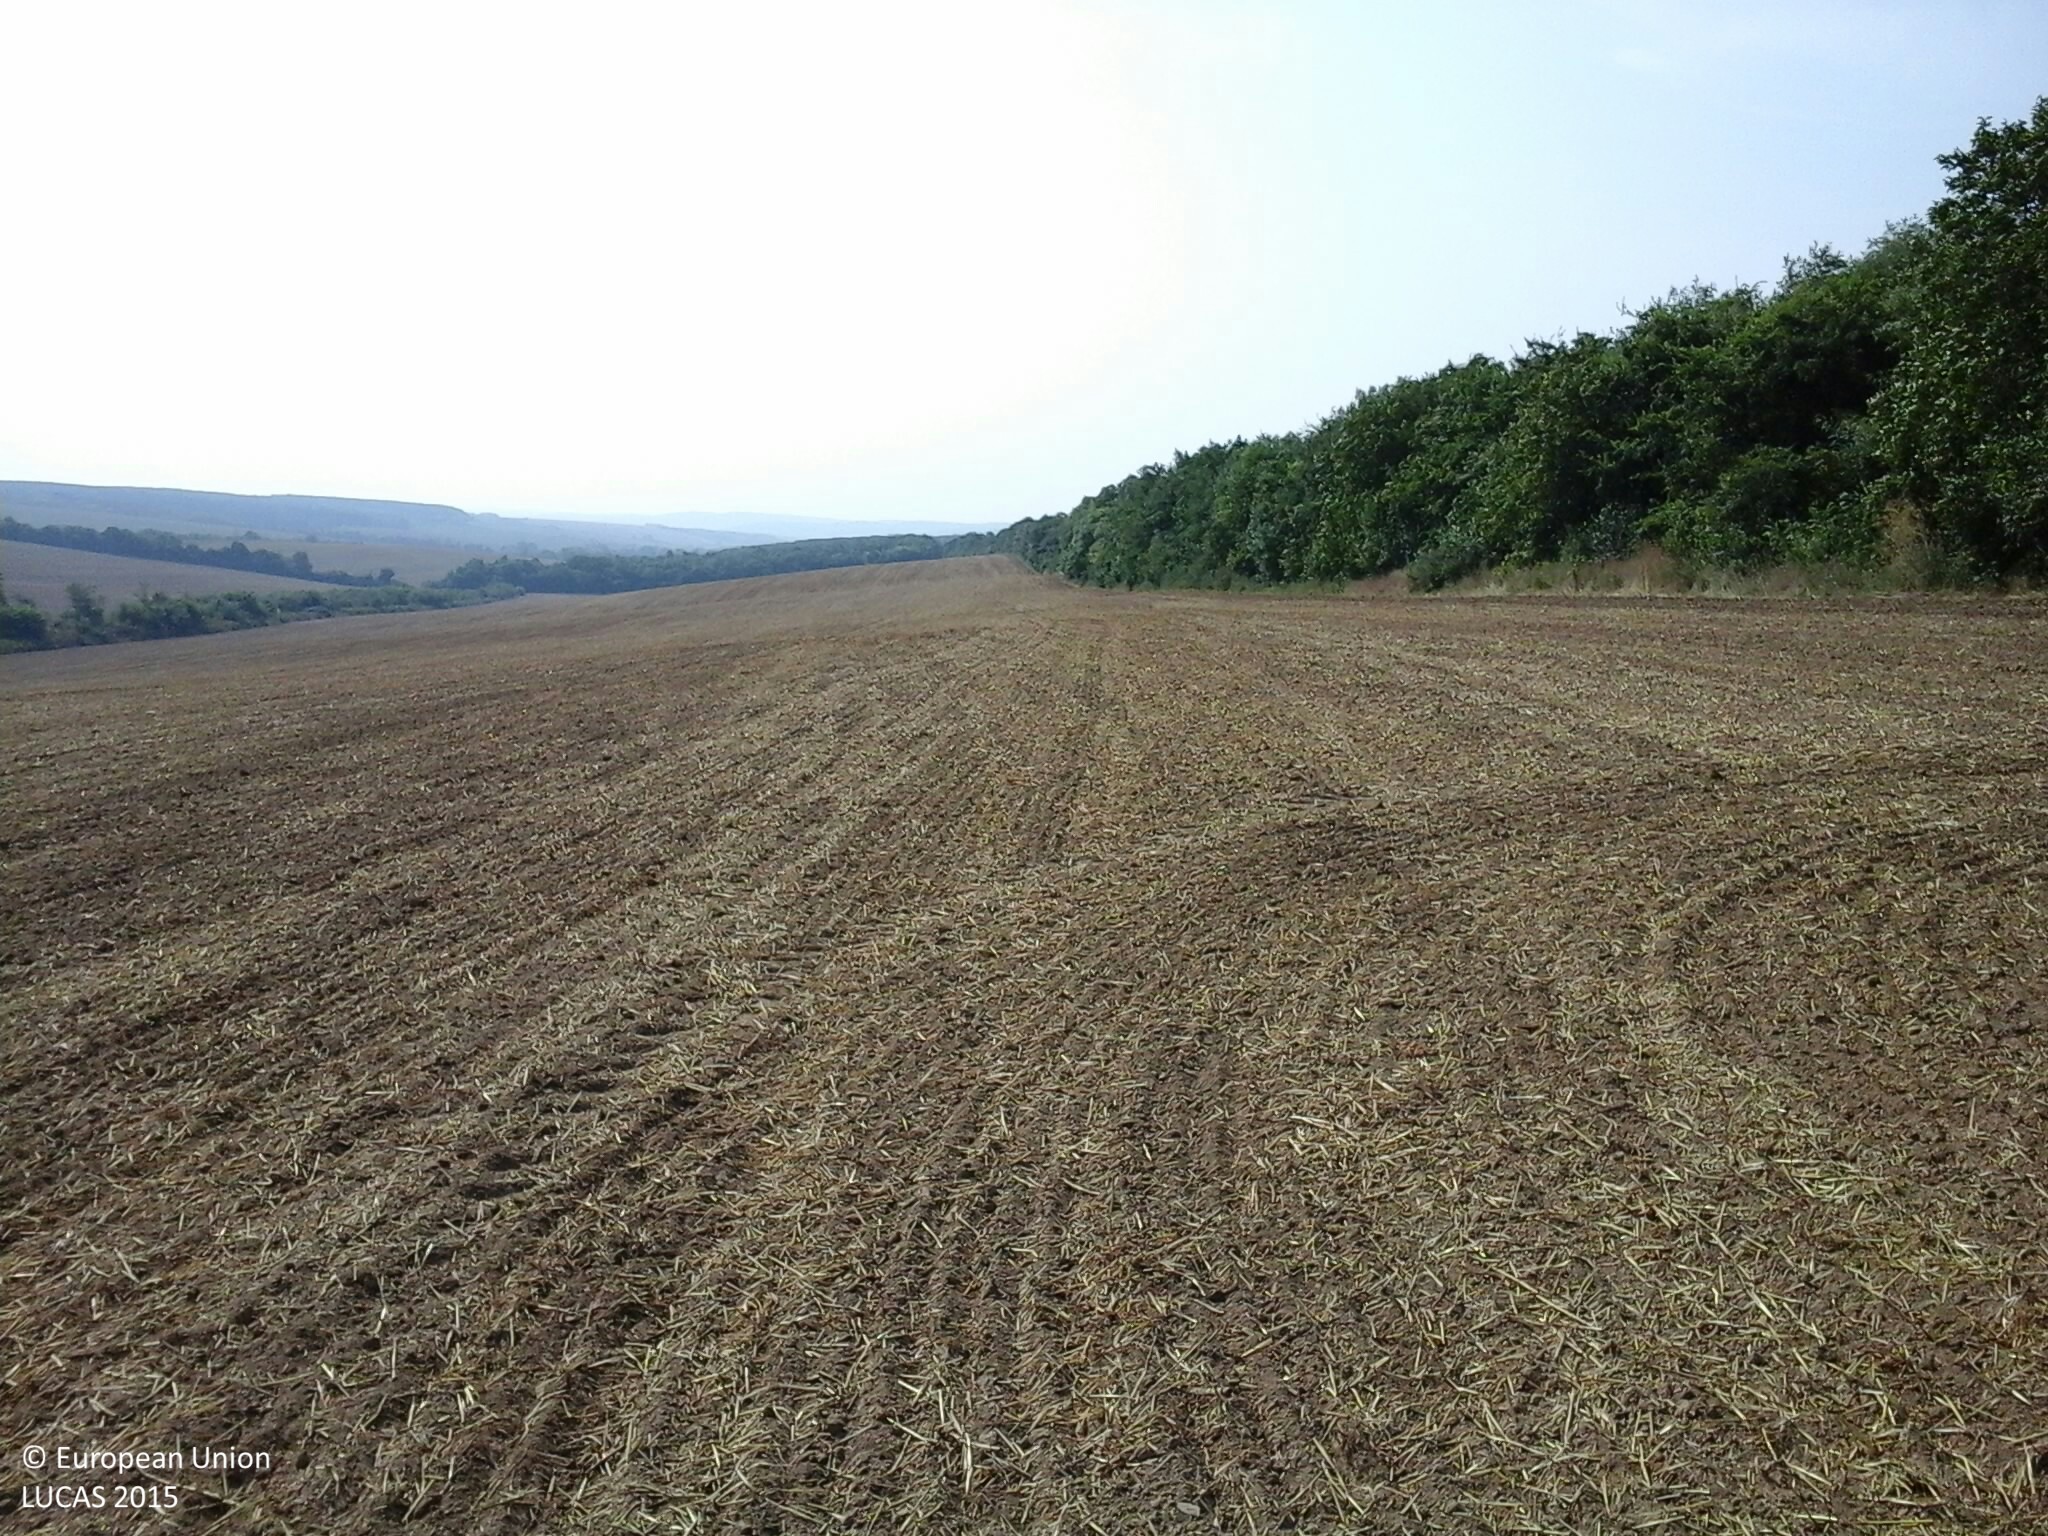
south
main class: Cropland
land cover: Durum wheat
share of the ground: < 10 %
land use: Agriculture (excluding fallow land and kitchen gardens)
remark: Harvested field
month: August
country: HU
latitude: 46.6669
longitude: 17.9939
